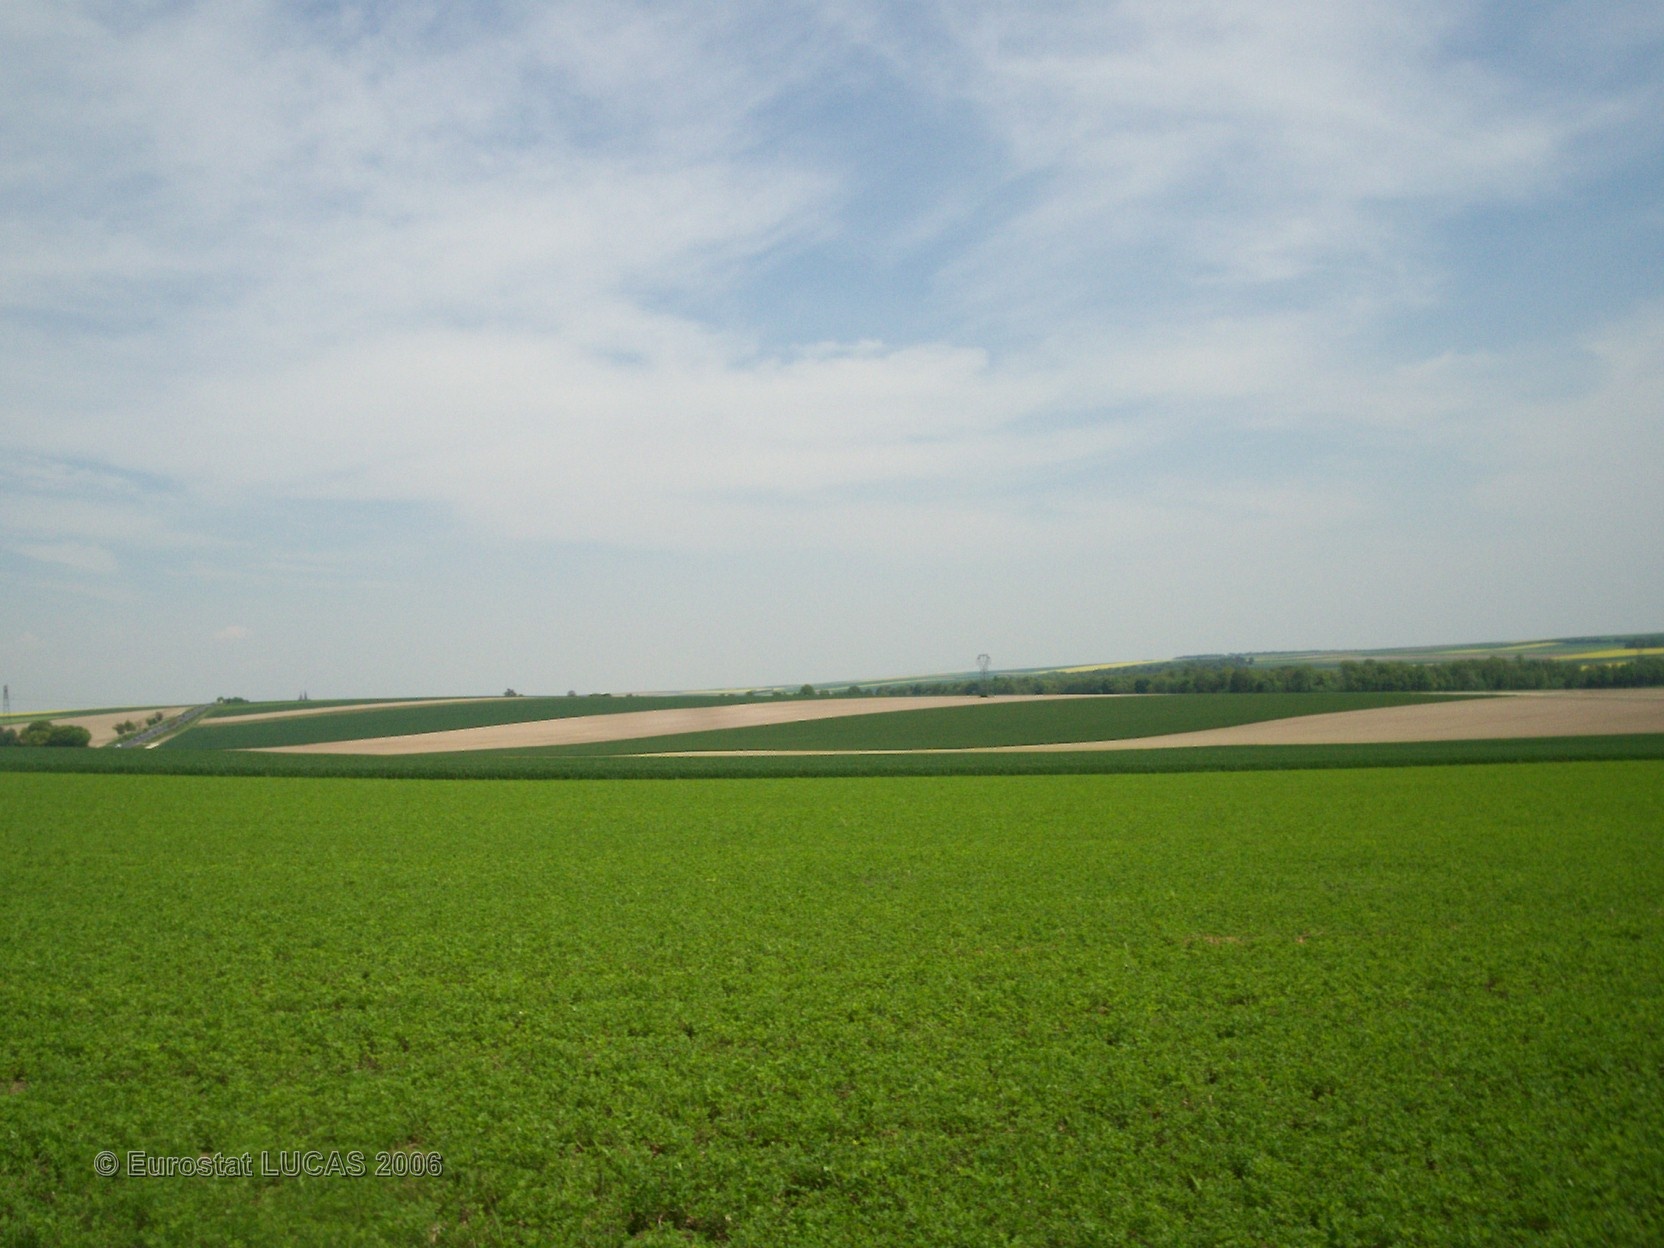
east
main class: Cropland
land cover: Lucerne
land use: Agriculture (excluding fallow land and kitchen gardens)
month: May
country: FR
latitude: 48.9654
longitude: 4.4098
